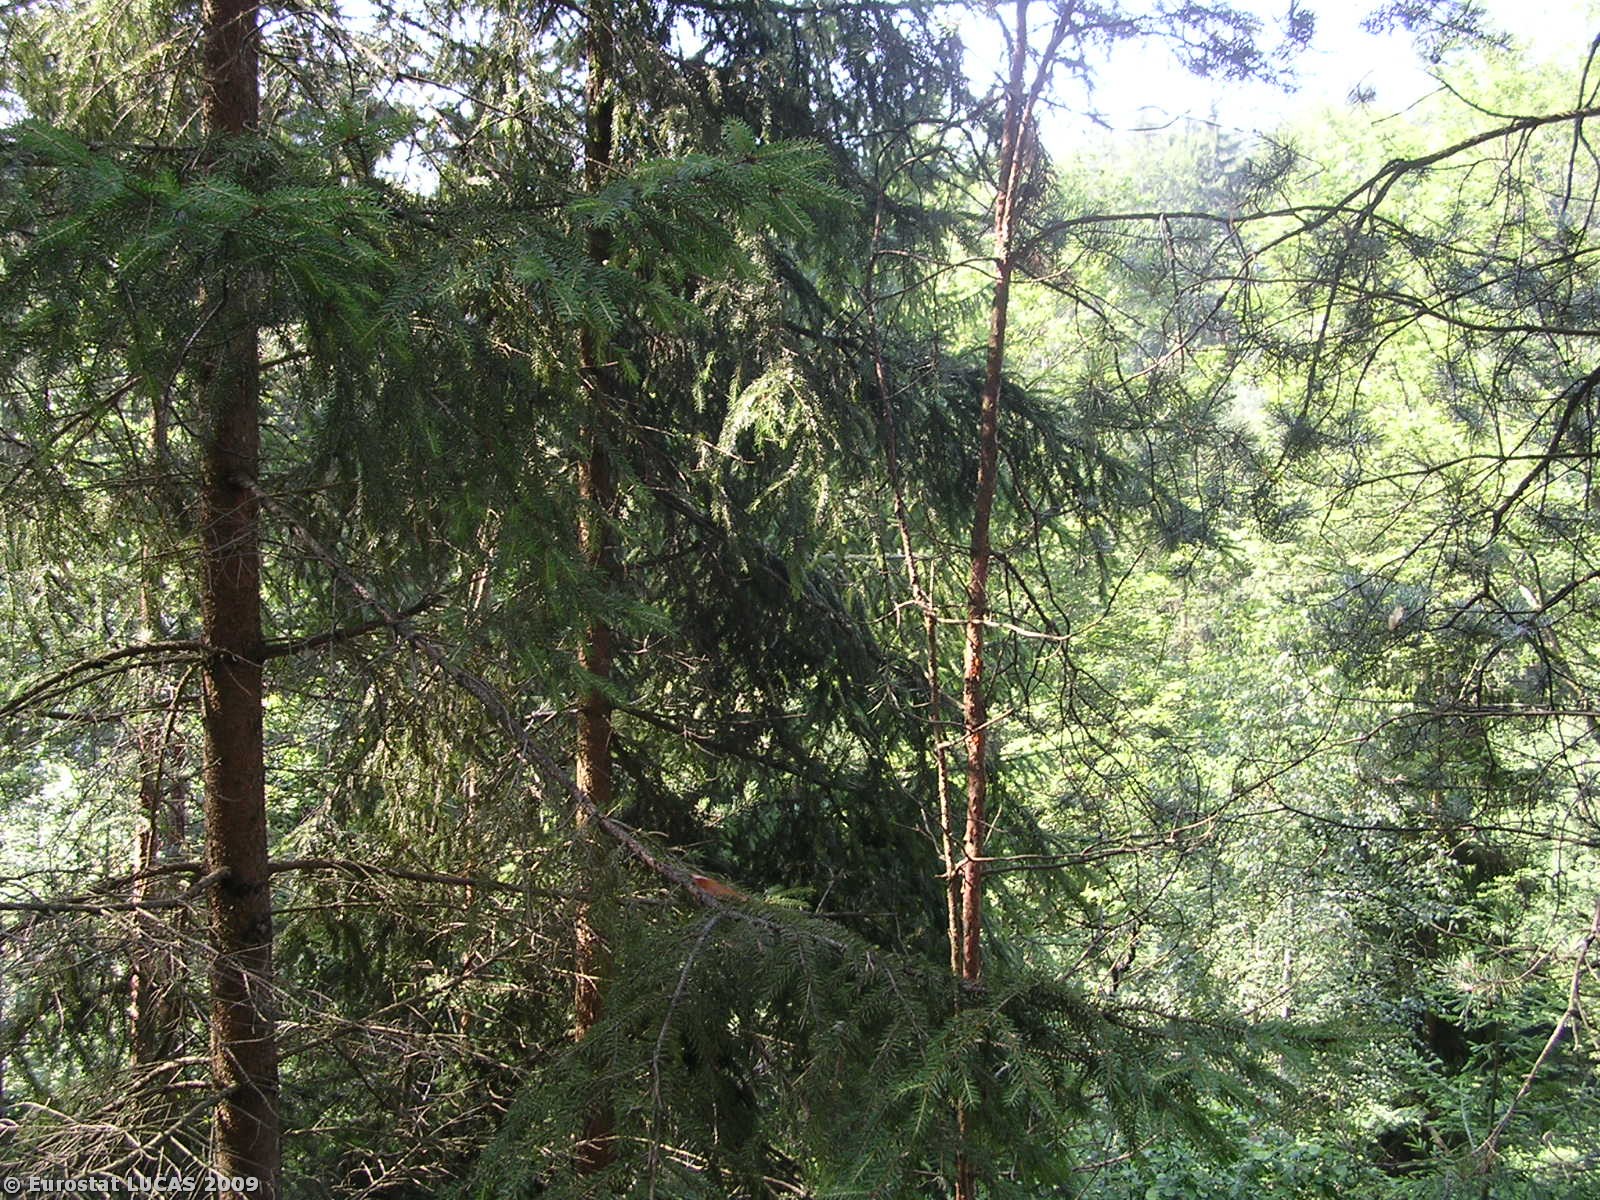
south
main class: Woodland
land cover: Coniferous woodland
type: hemiboreal forest and nemoral coniferous forest and mixed broadleaved-coniferous forest
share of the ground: > 75 %
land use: Forestry
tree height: > 5 m
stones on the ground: < 10 %
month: July
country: CZ
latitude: 50.5987
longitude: 14.9617
